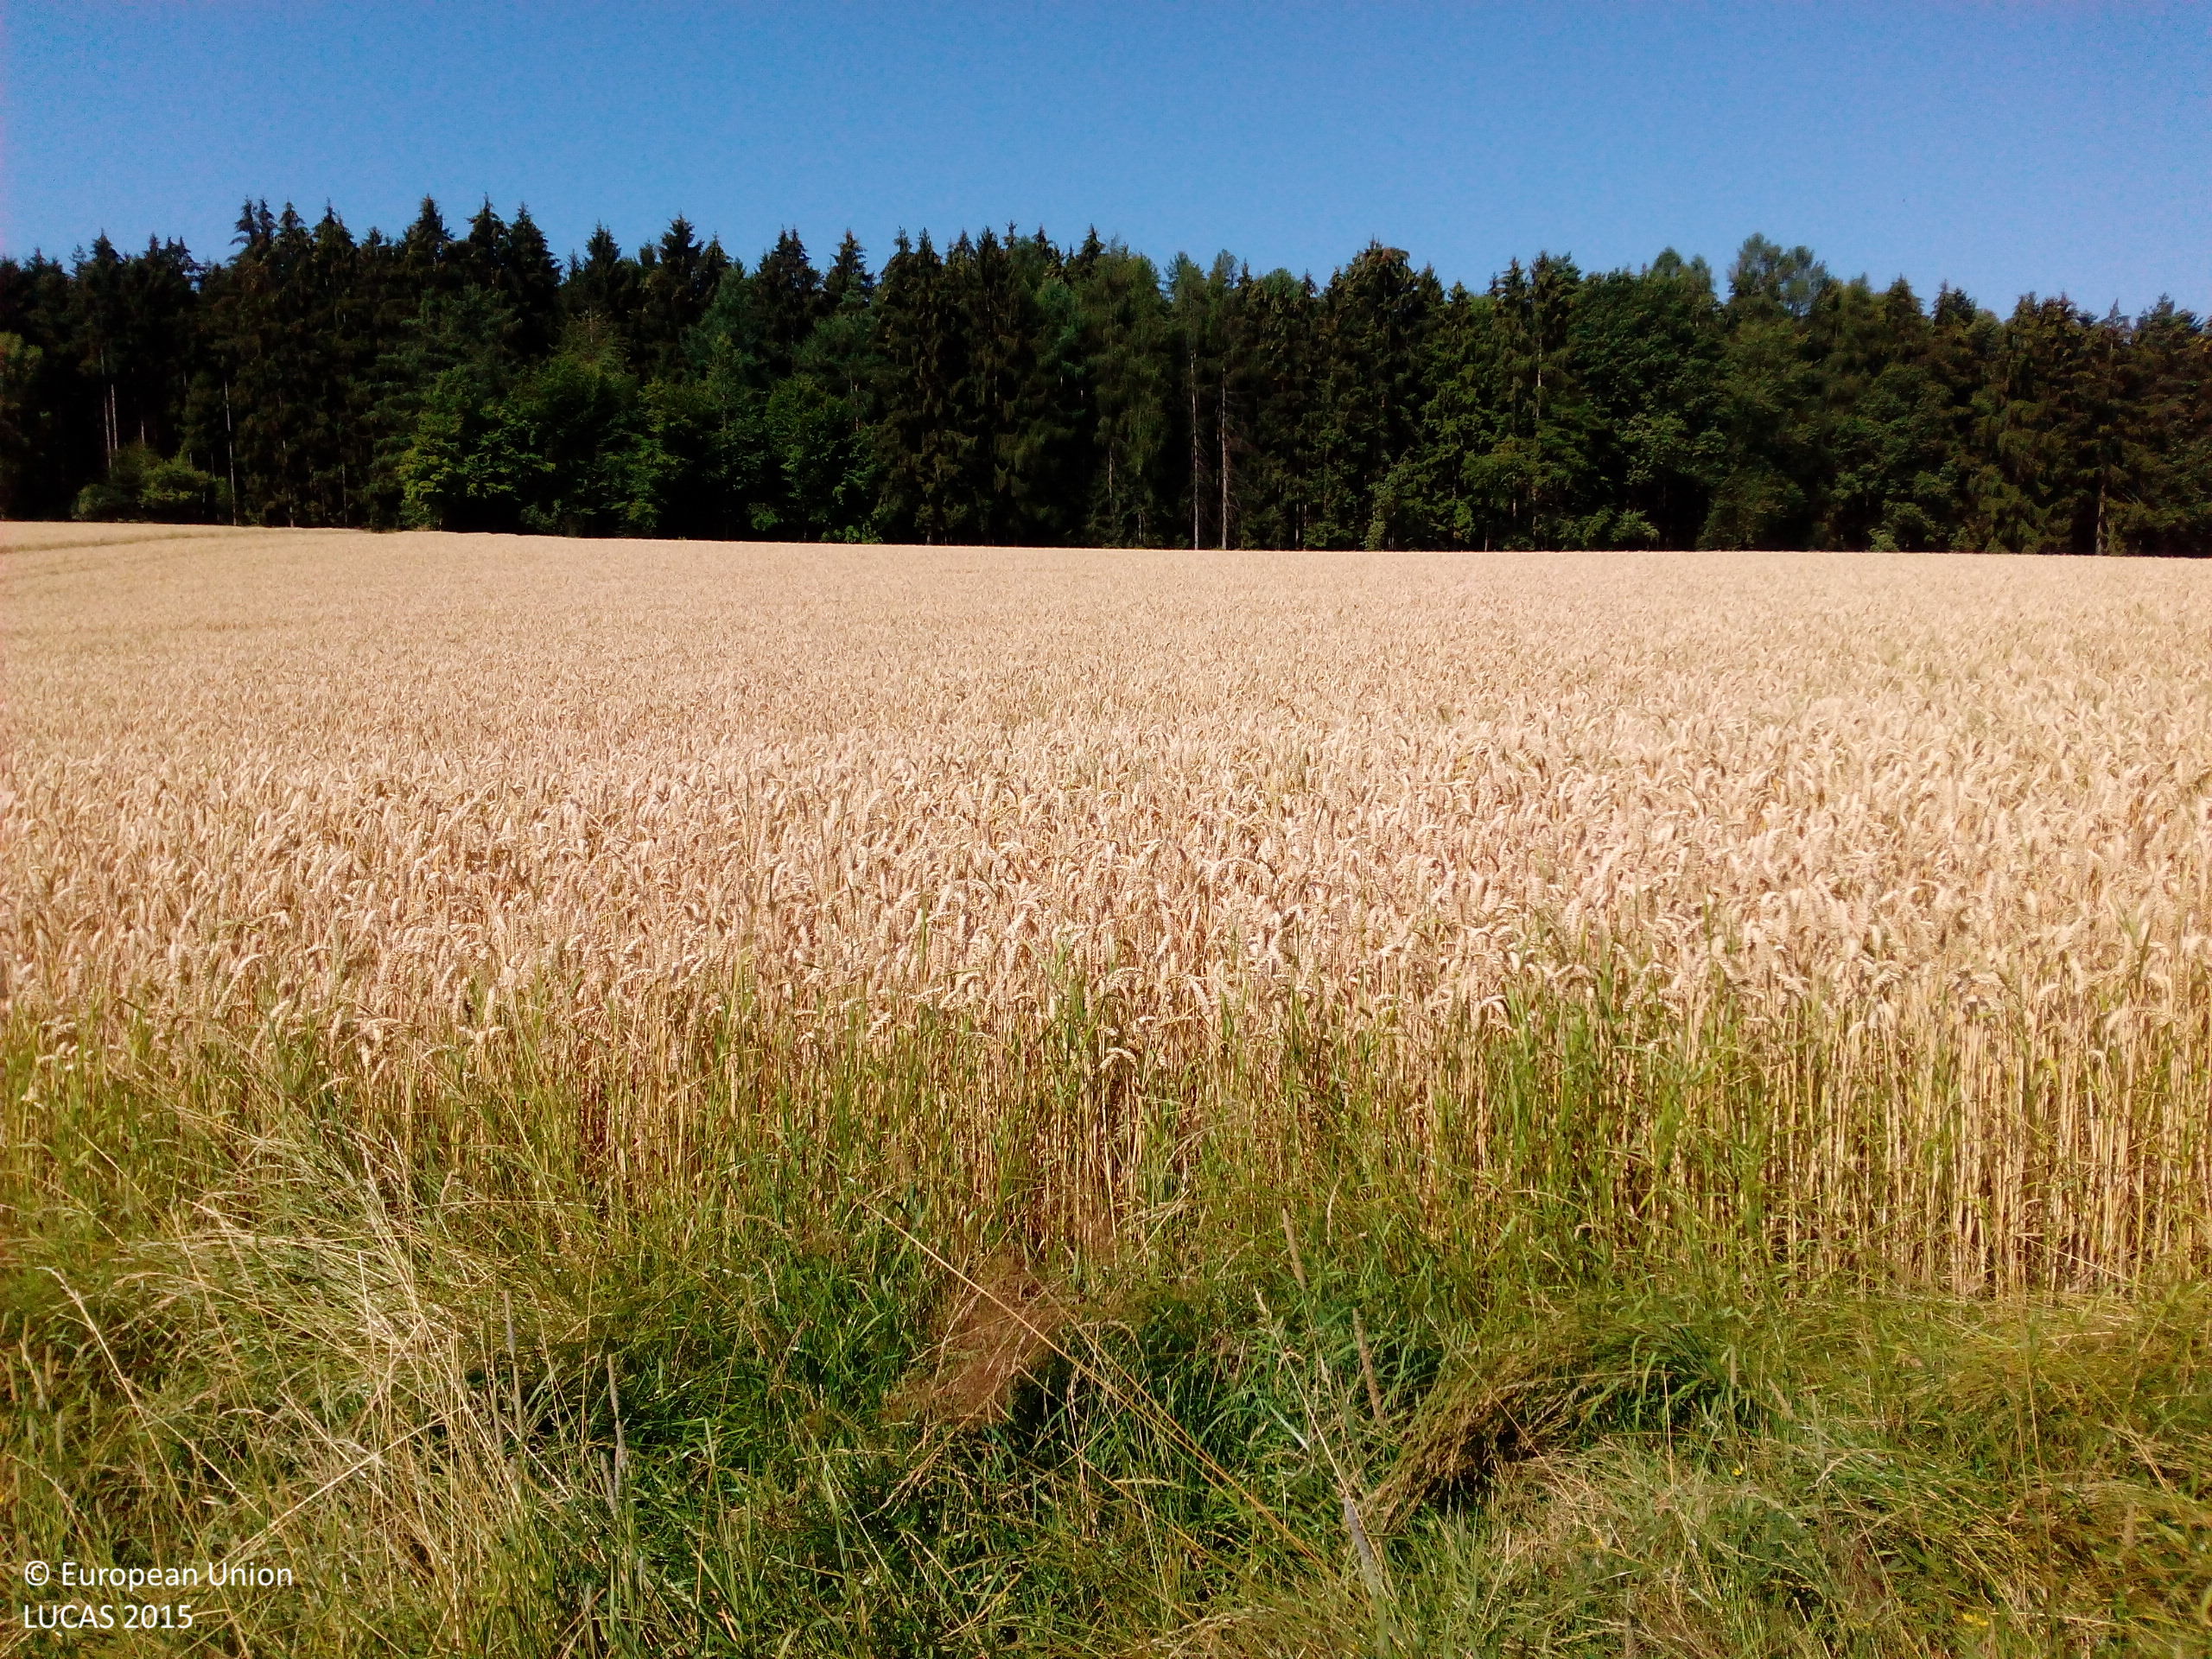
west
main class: Cropland
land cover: Apple fruit
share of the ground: 10 - 25 %
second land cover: Grassland without tree/shrub cover
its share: > 75 %
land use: Agriculture (excluding fallow land and kitchen gardens)
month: July
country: DE
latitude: 48.5805
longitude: 12.9408
